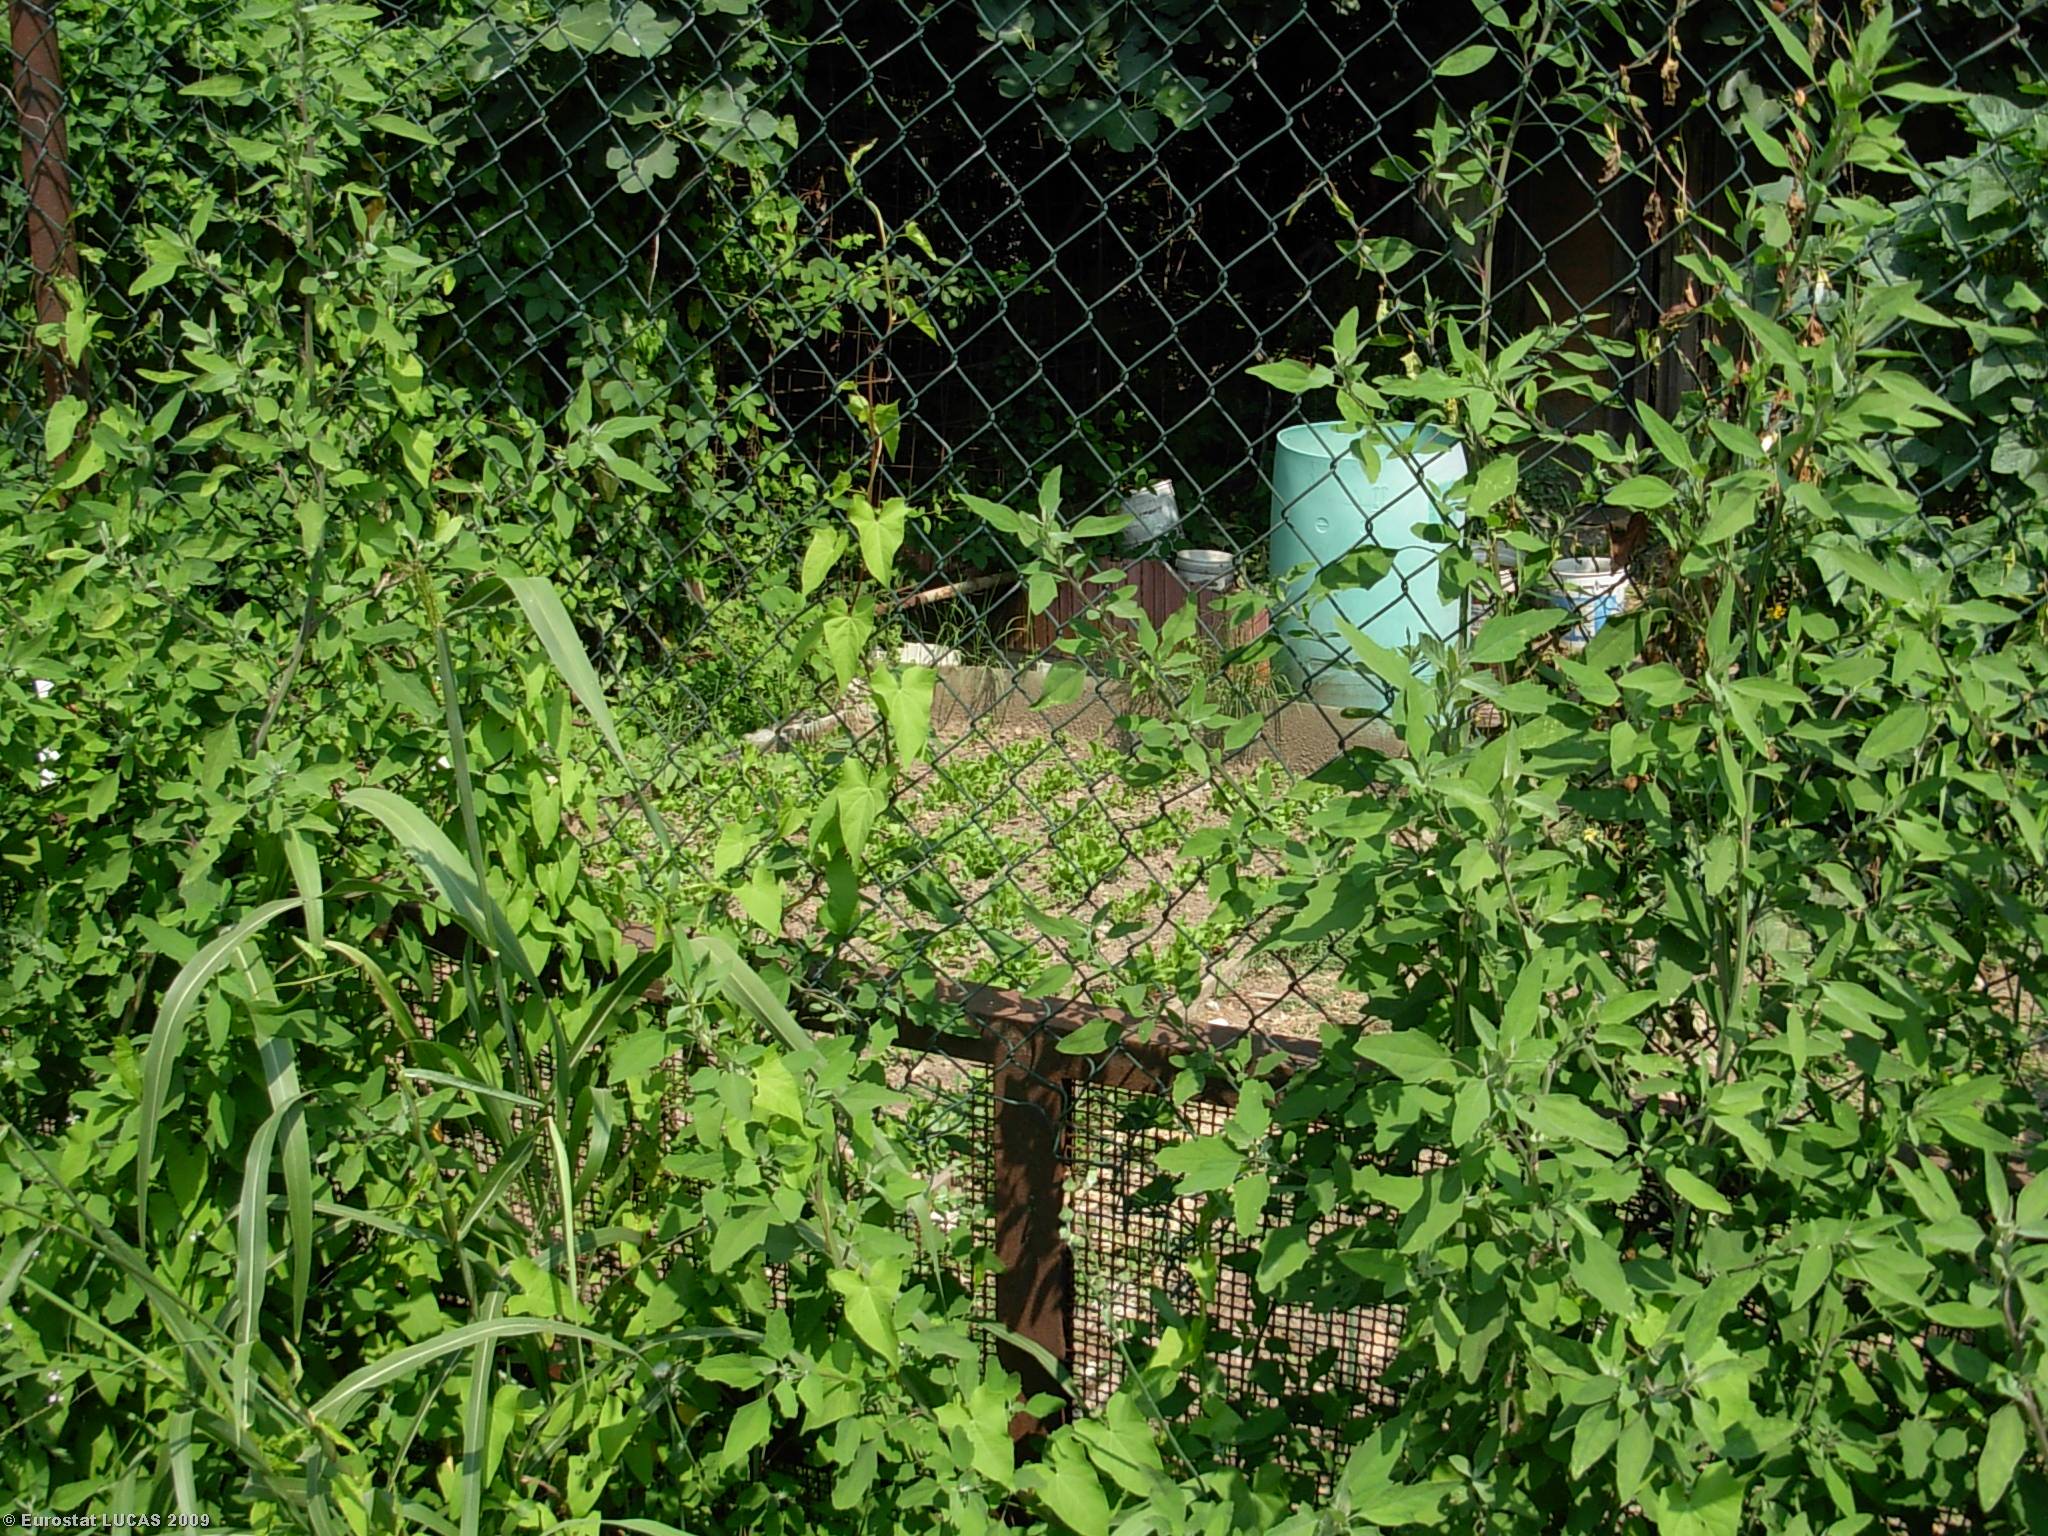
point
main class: Cropland
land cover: Other fresh vegetables
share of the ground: 50 - 75 %
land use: Kitchen garden
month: July
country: IT
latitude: 45.5379
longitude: 9.2713
